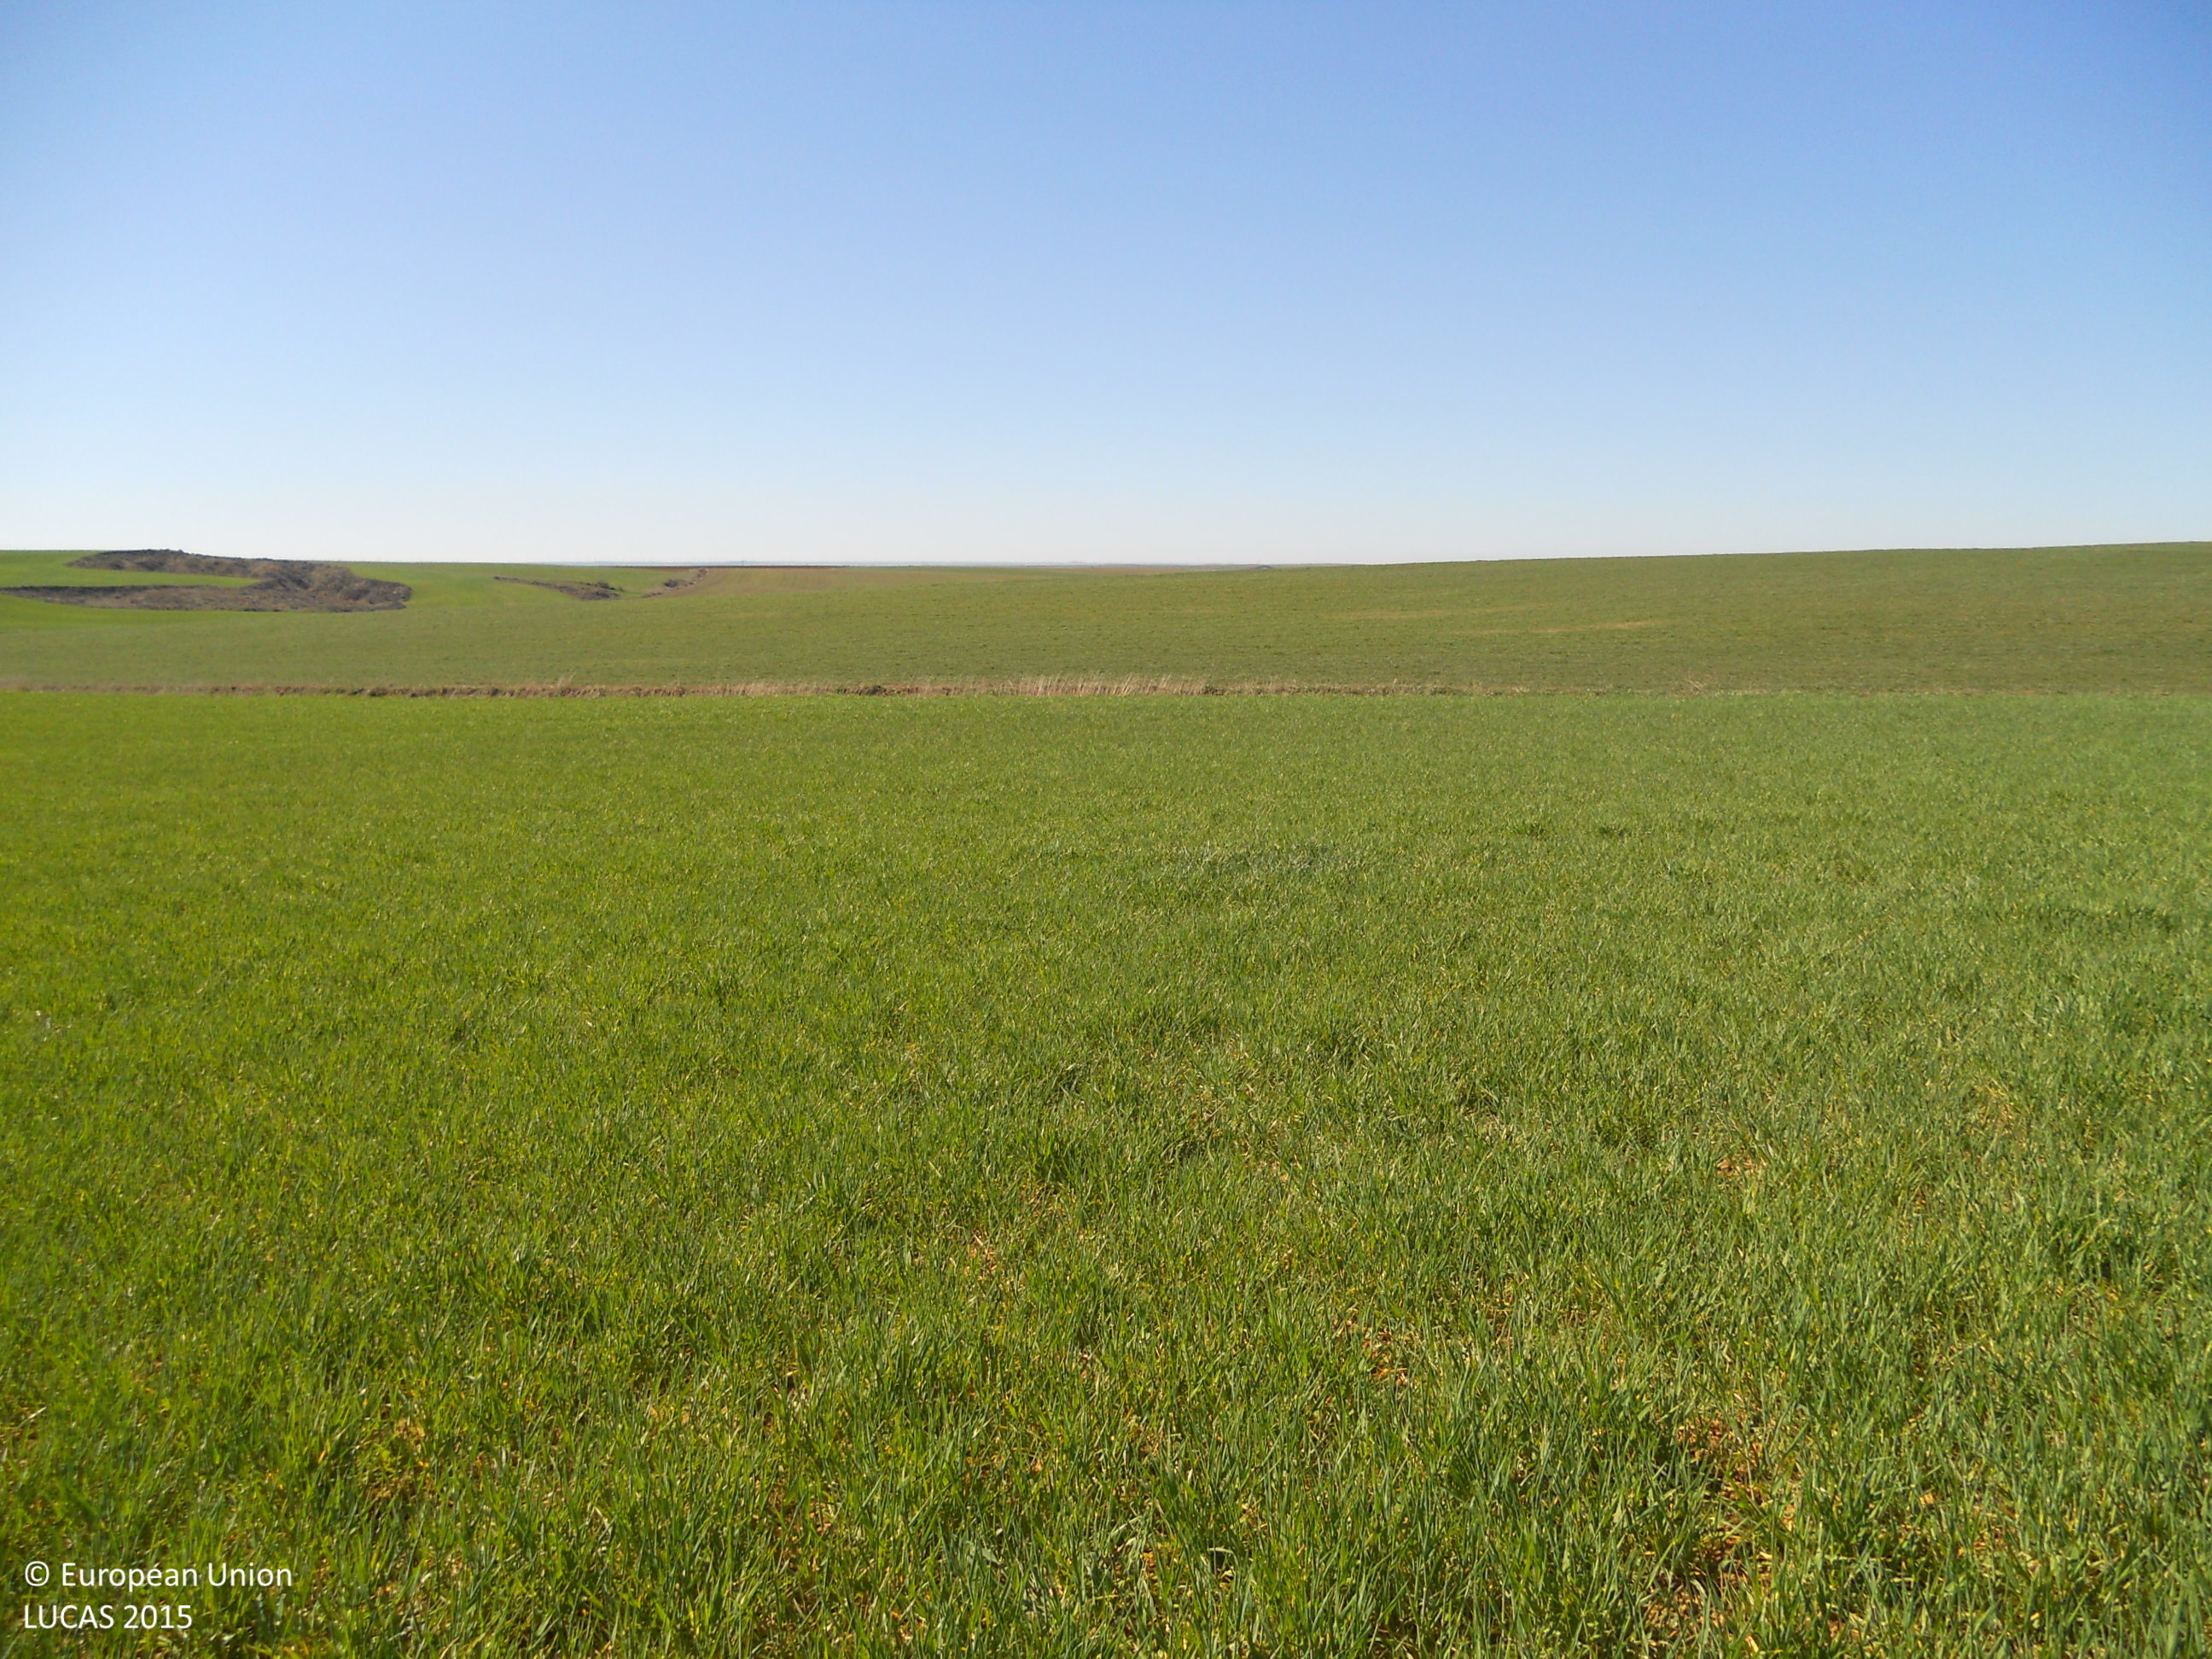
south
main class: Cropland
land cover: Barley
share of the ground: > 75 %
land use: Agriculture (excluding fallow land and kitchen gardens)
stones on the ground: < 10 %
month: April
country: ES
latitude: 42.2414
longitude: -4.7773
